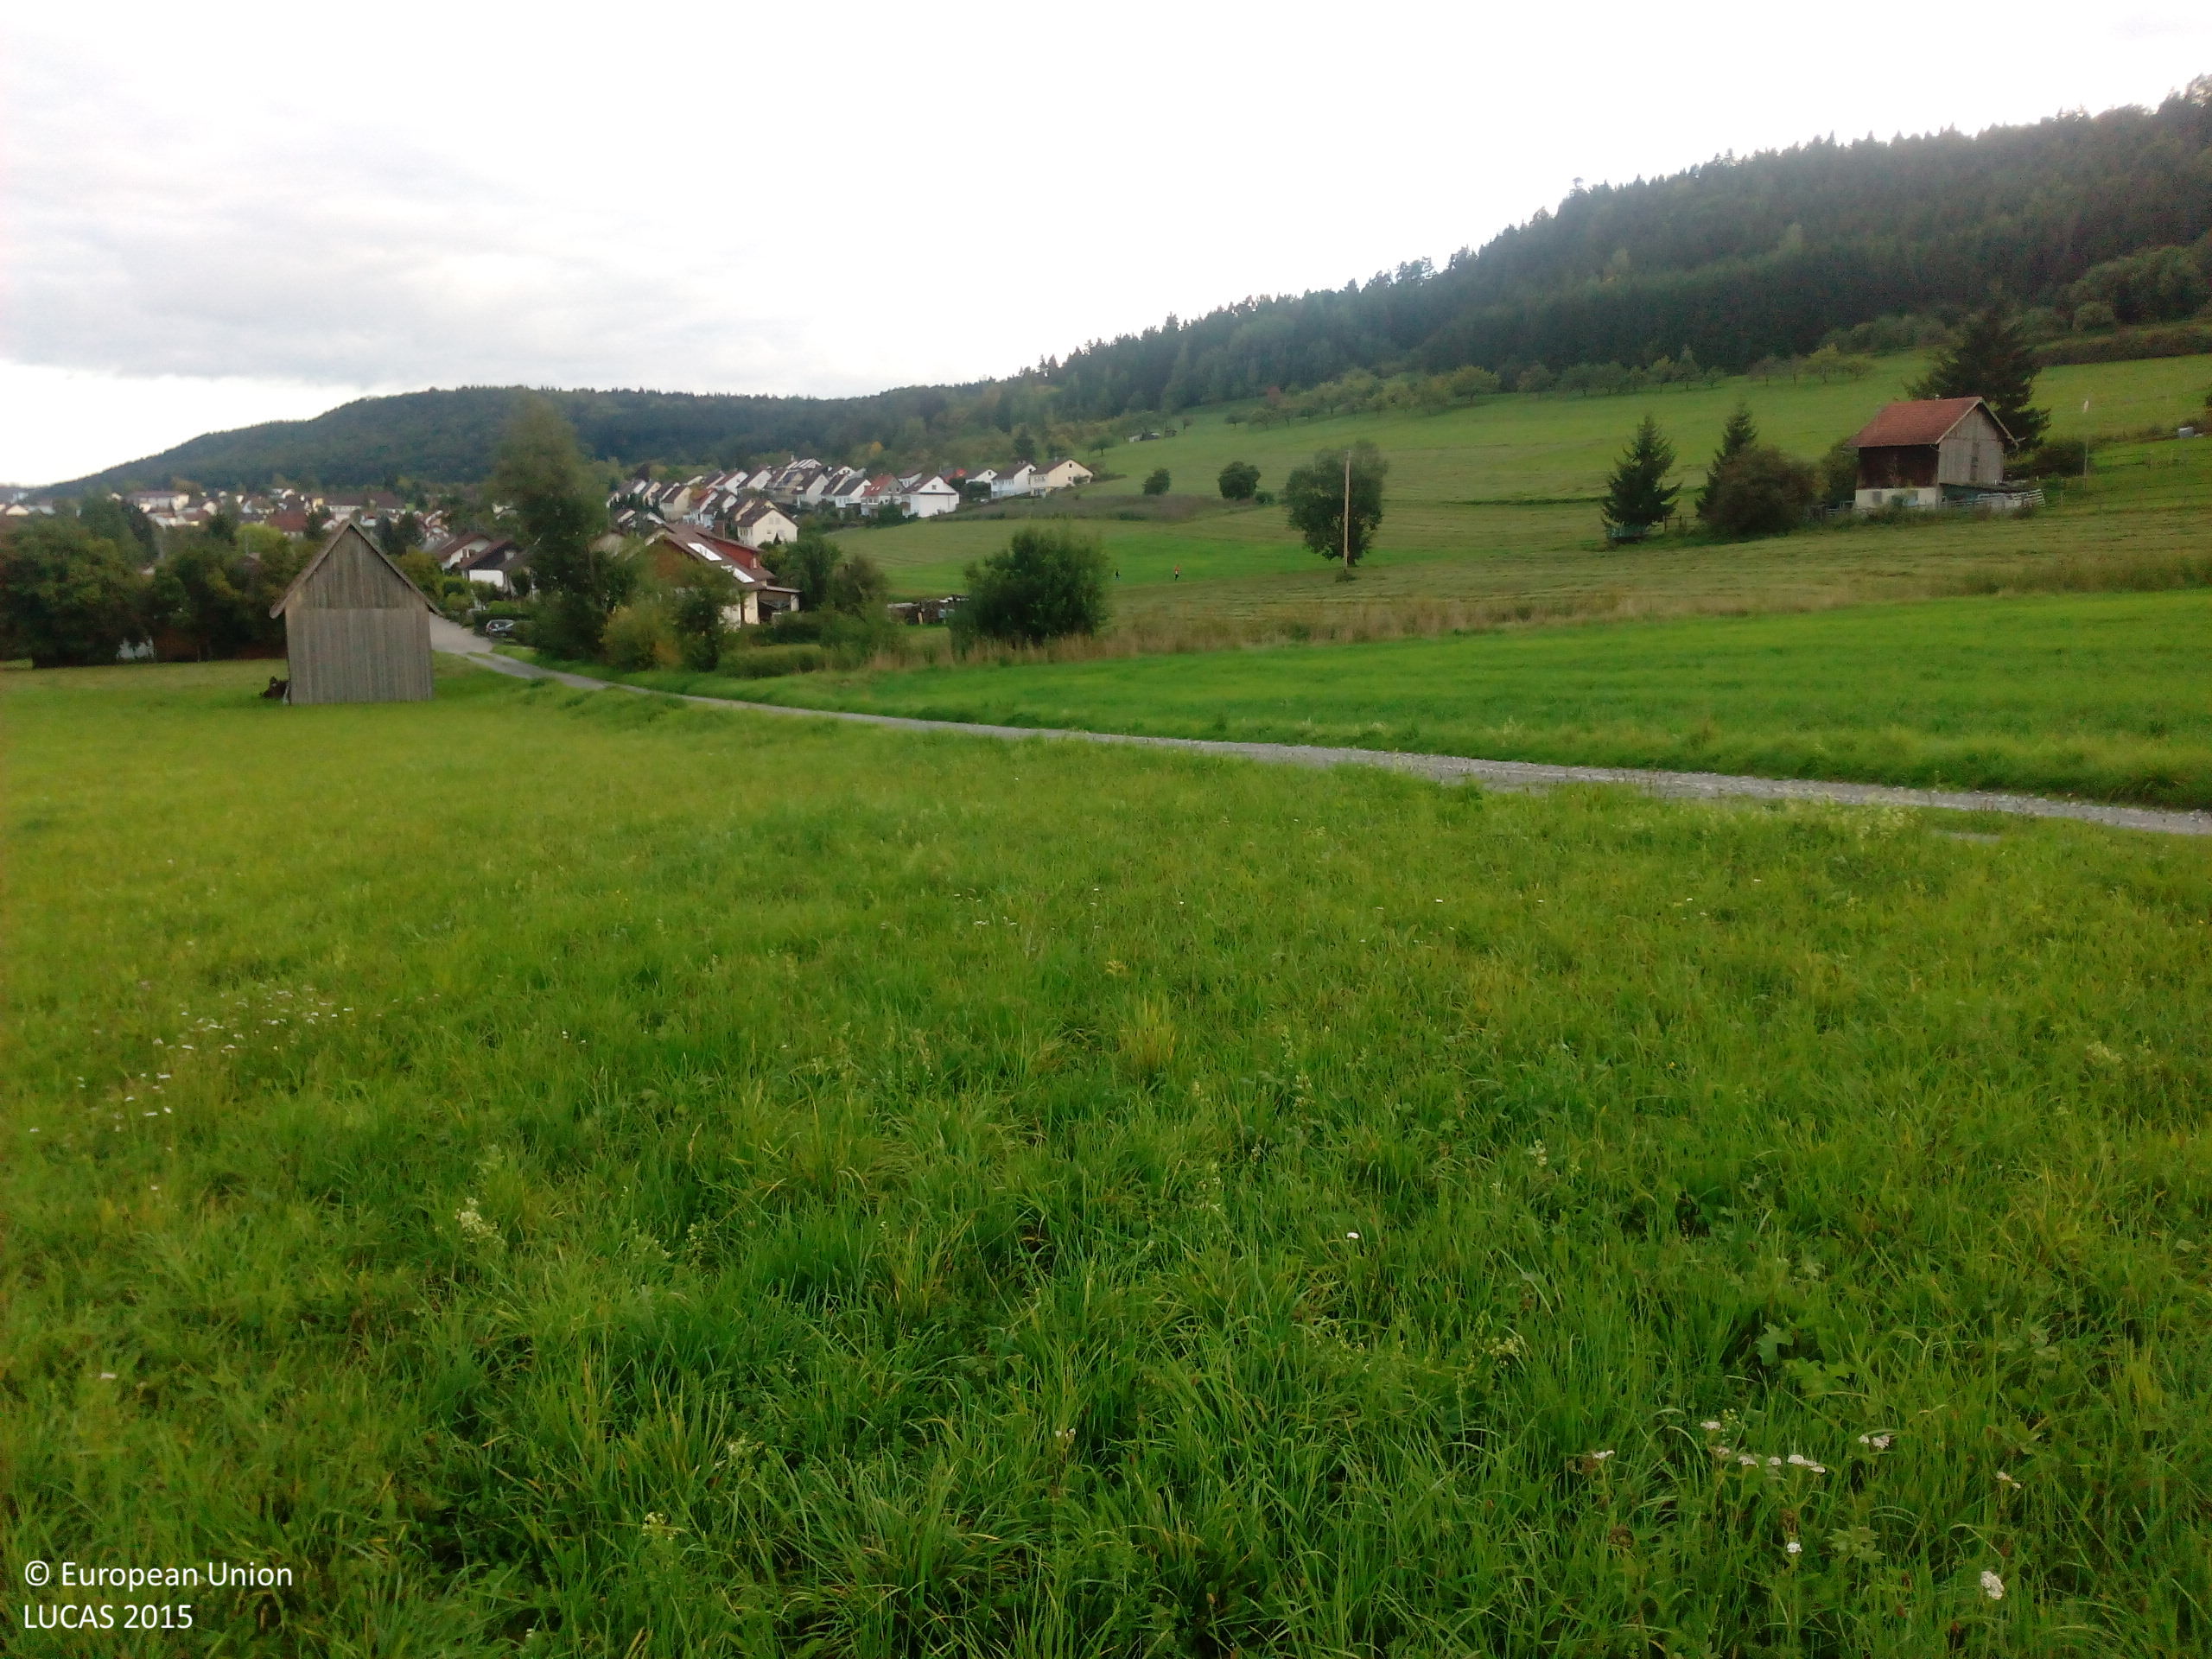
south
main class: Grassland
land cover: Grassland without tree/shrub cover
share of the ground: > 75 %
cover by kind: herbaceous plants 100 %
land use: Agriculture (excluding fallow land and kitchen gardens)
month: September
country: DE
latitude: 48.5756
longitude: 8.6859
